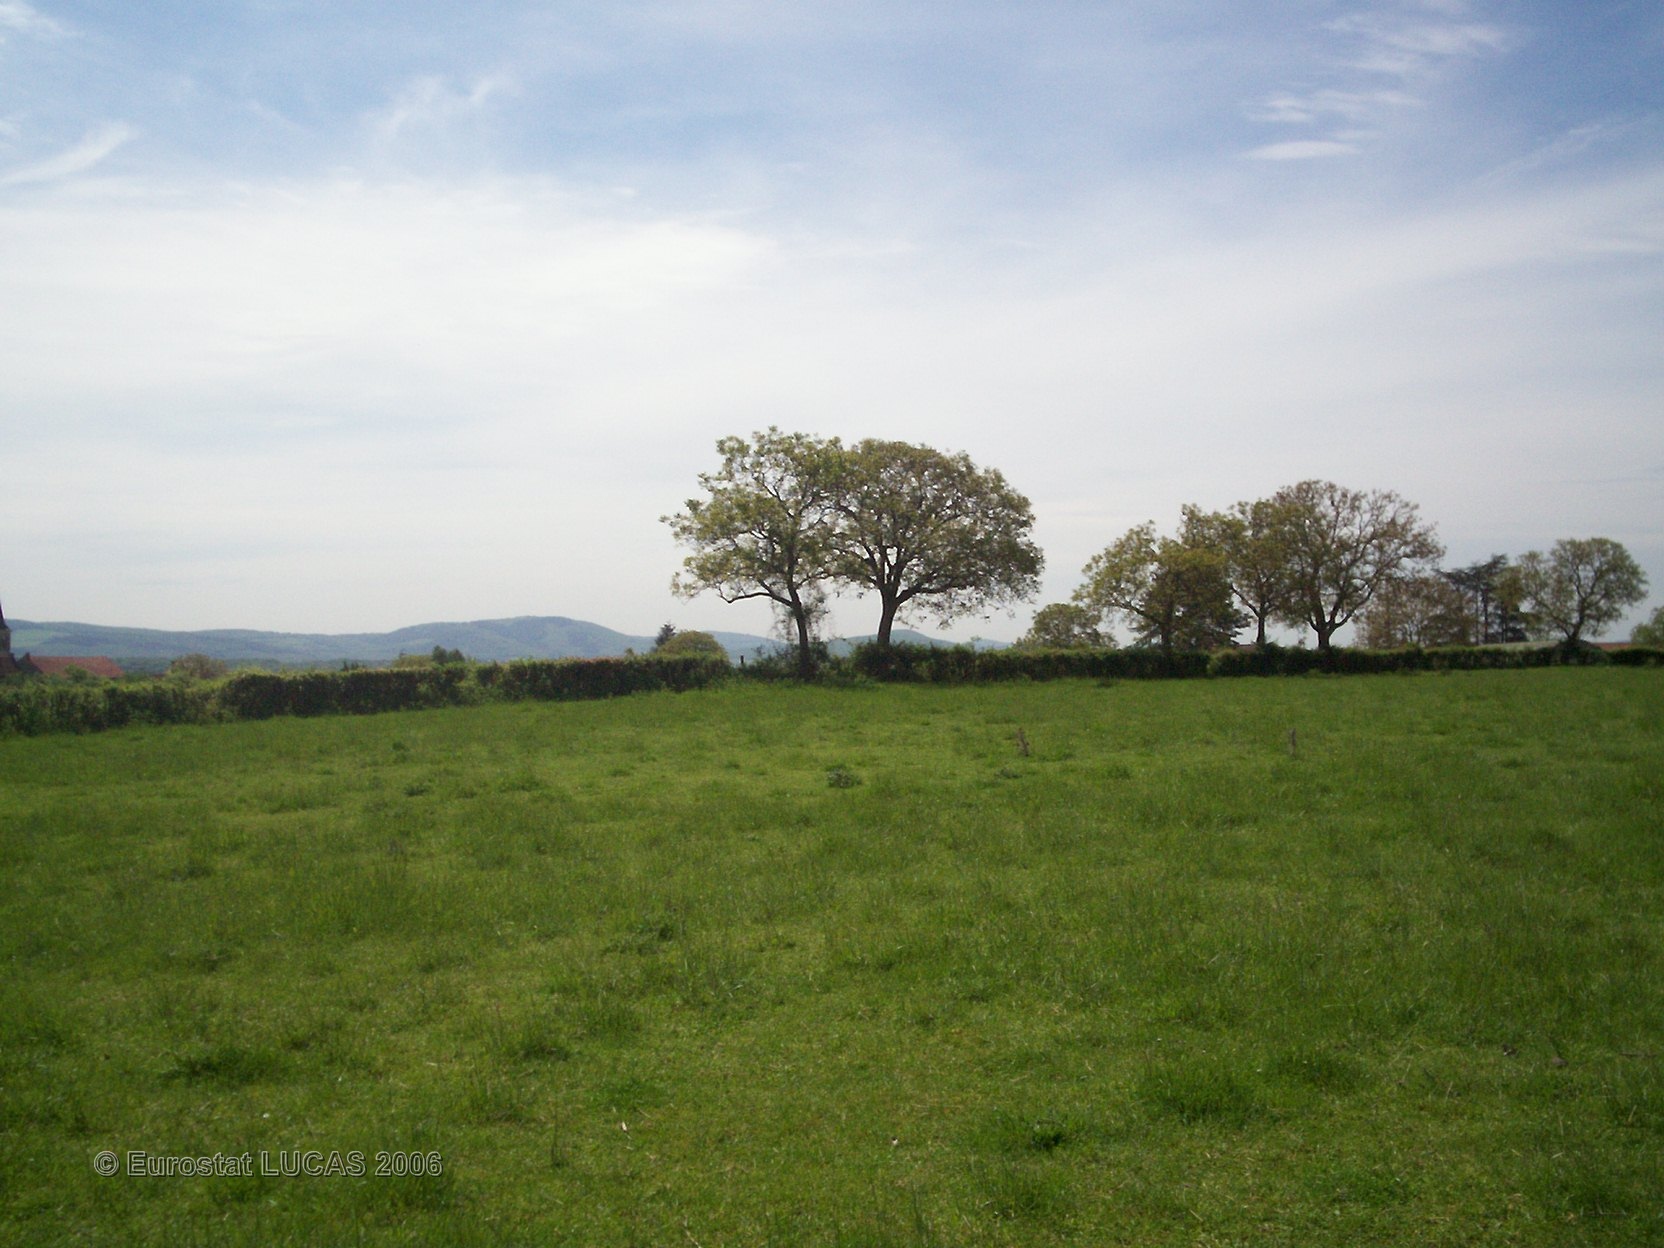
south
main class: Grassland
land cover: Grassland without tree/shrub cover
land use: Agriculture (excluding fallow land and kitchen gardens)
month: May
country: FR
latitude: 46.5829
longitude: 4.7424
